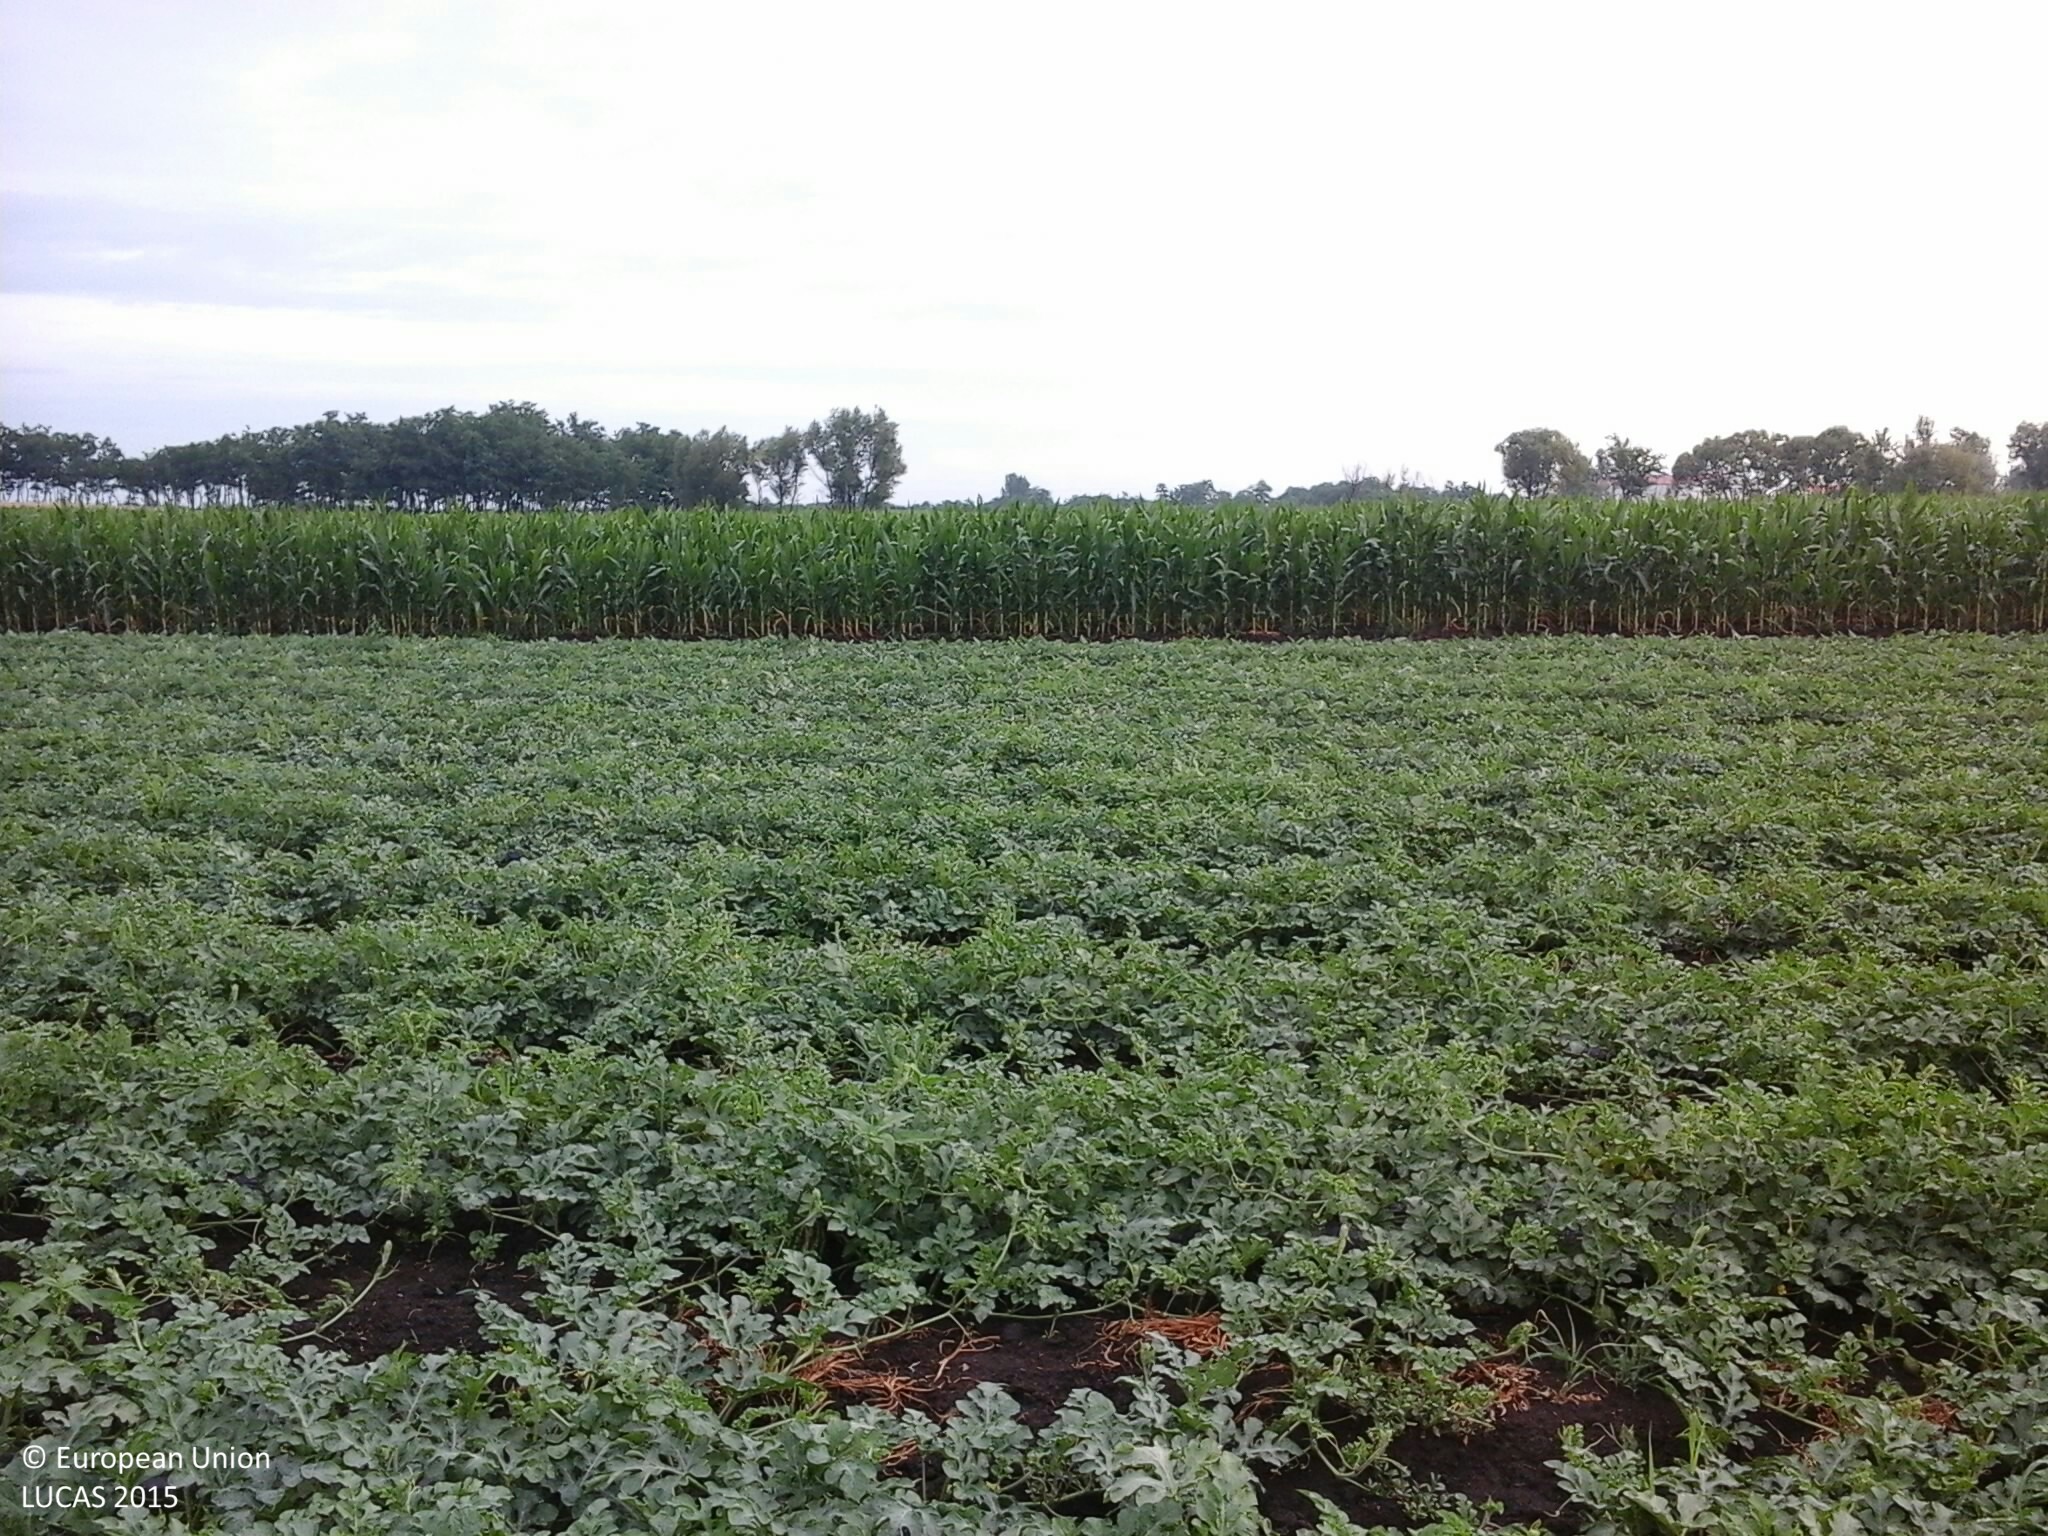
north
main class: Cropland
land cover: Other fresh vegetables
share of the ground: 50 - 75 %
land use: Agriculture (excluding fallow land and kitchen gardens)
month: July
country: HU
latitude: 47.8133
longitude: 21.8952
